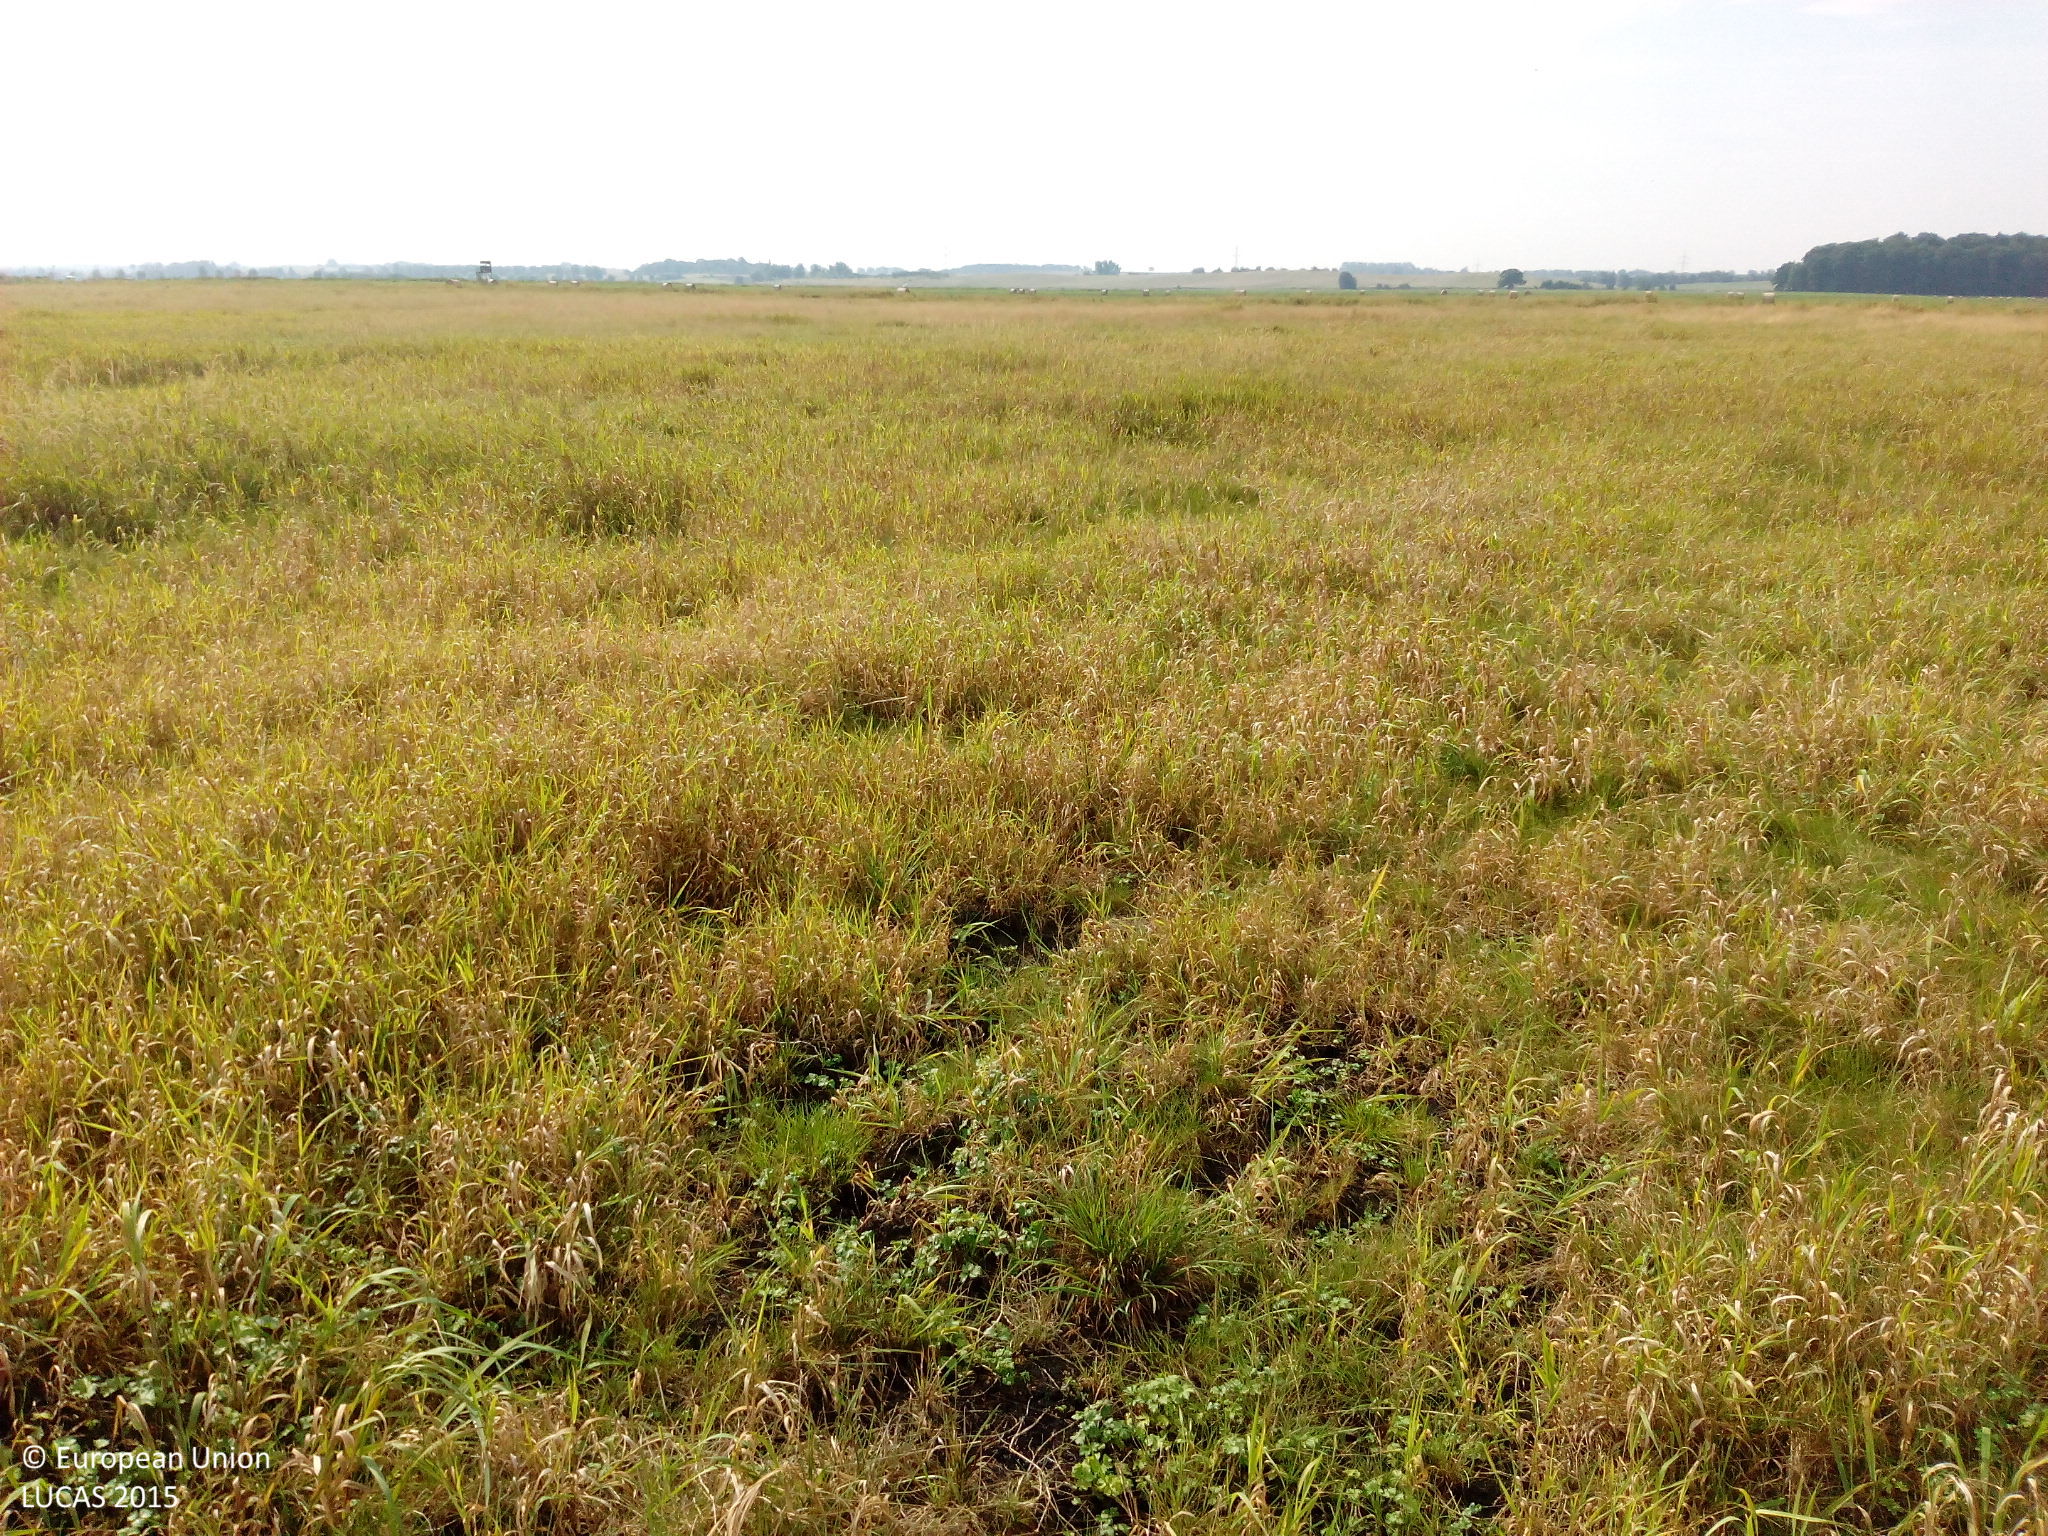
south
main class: Grassland
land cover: Grassland without tree/shrub cover
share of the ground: > 75 %
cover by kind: herbaceous plants 100 %
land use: Agriculture (excluding fallow land and kitchen gardens)
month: August
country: DE
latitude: 54.1469
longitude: 12.6170
